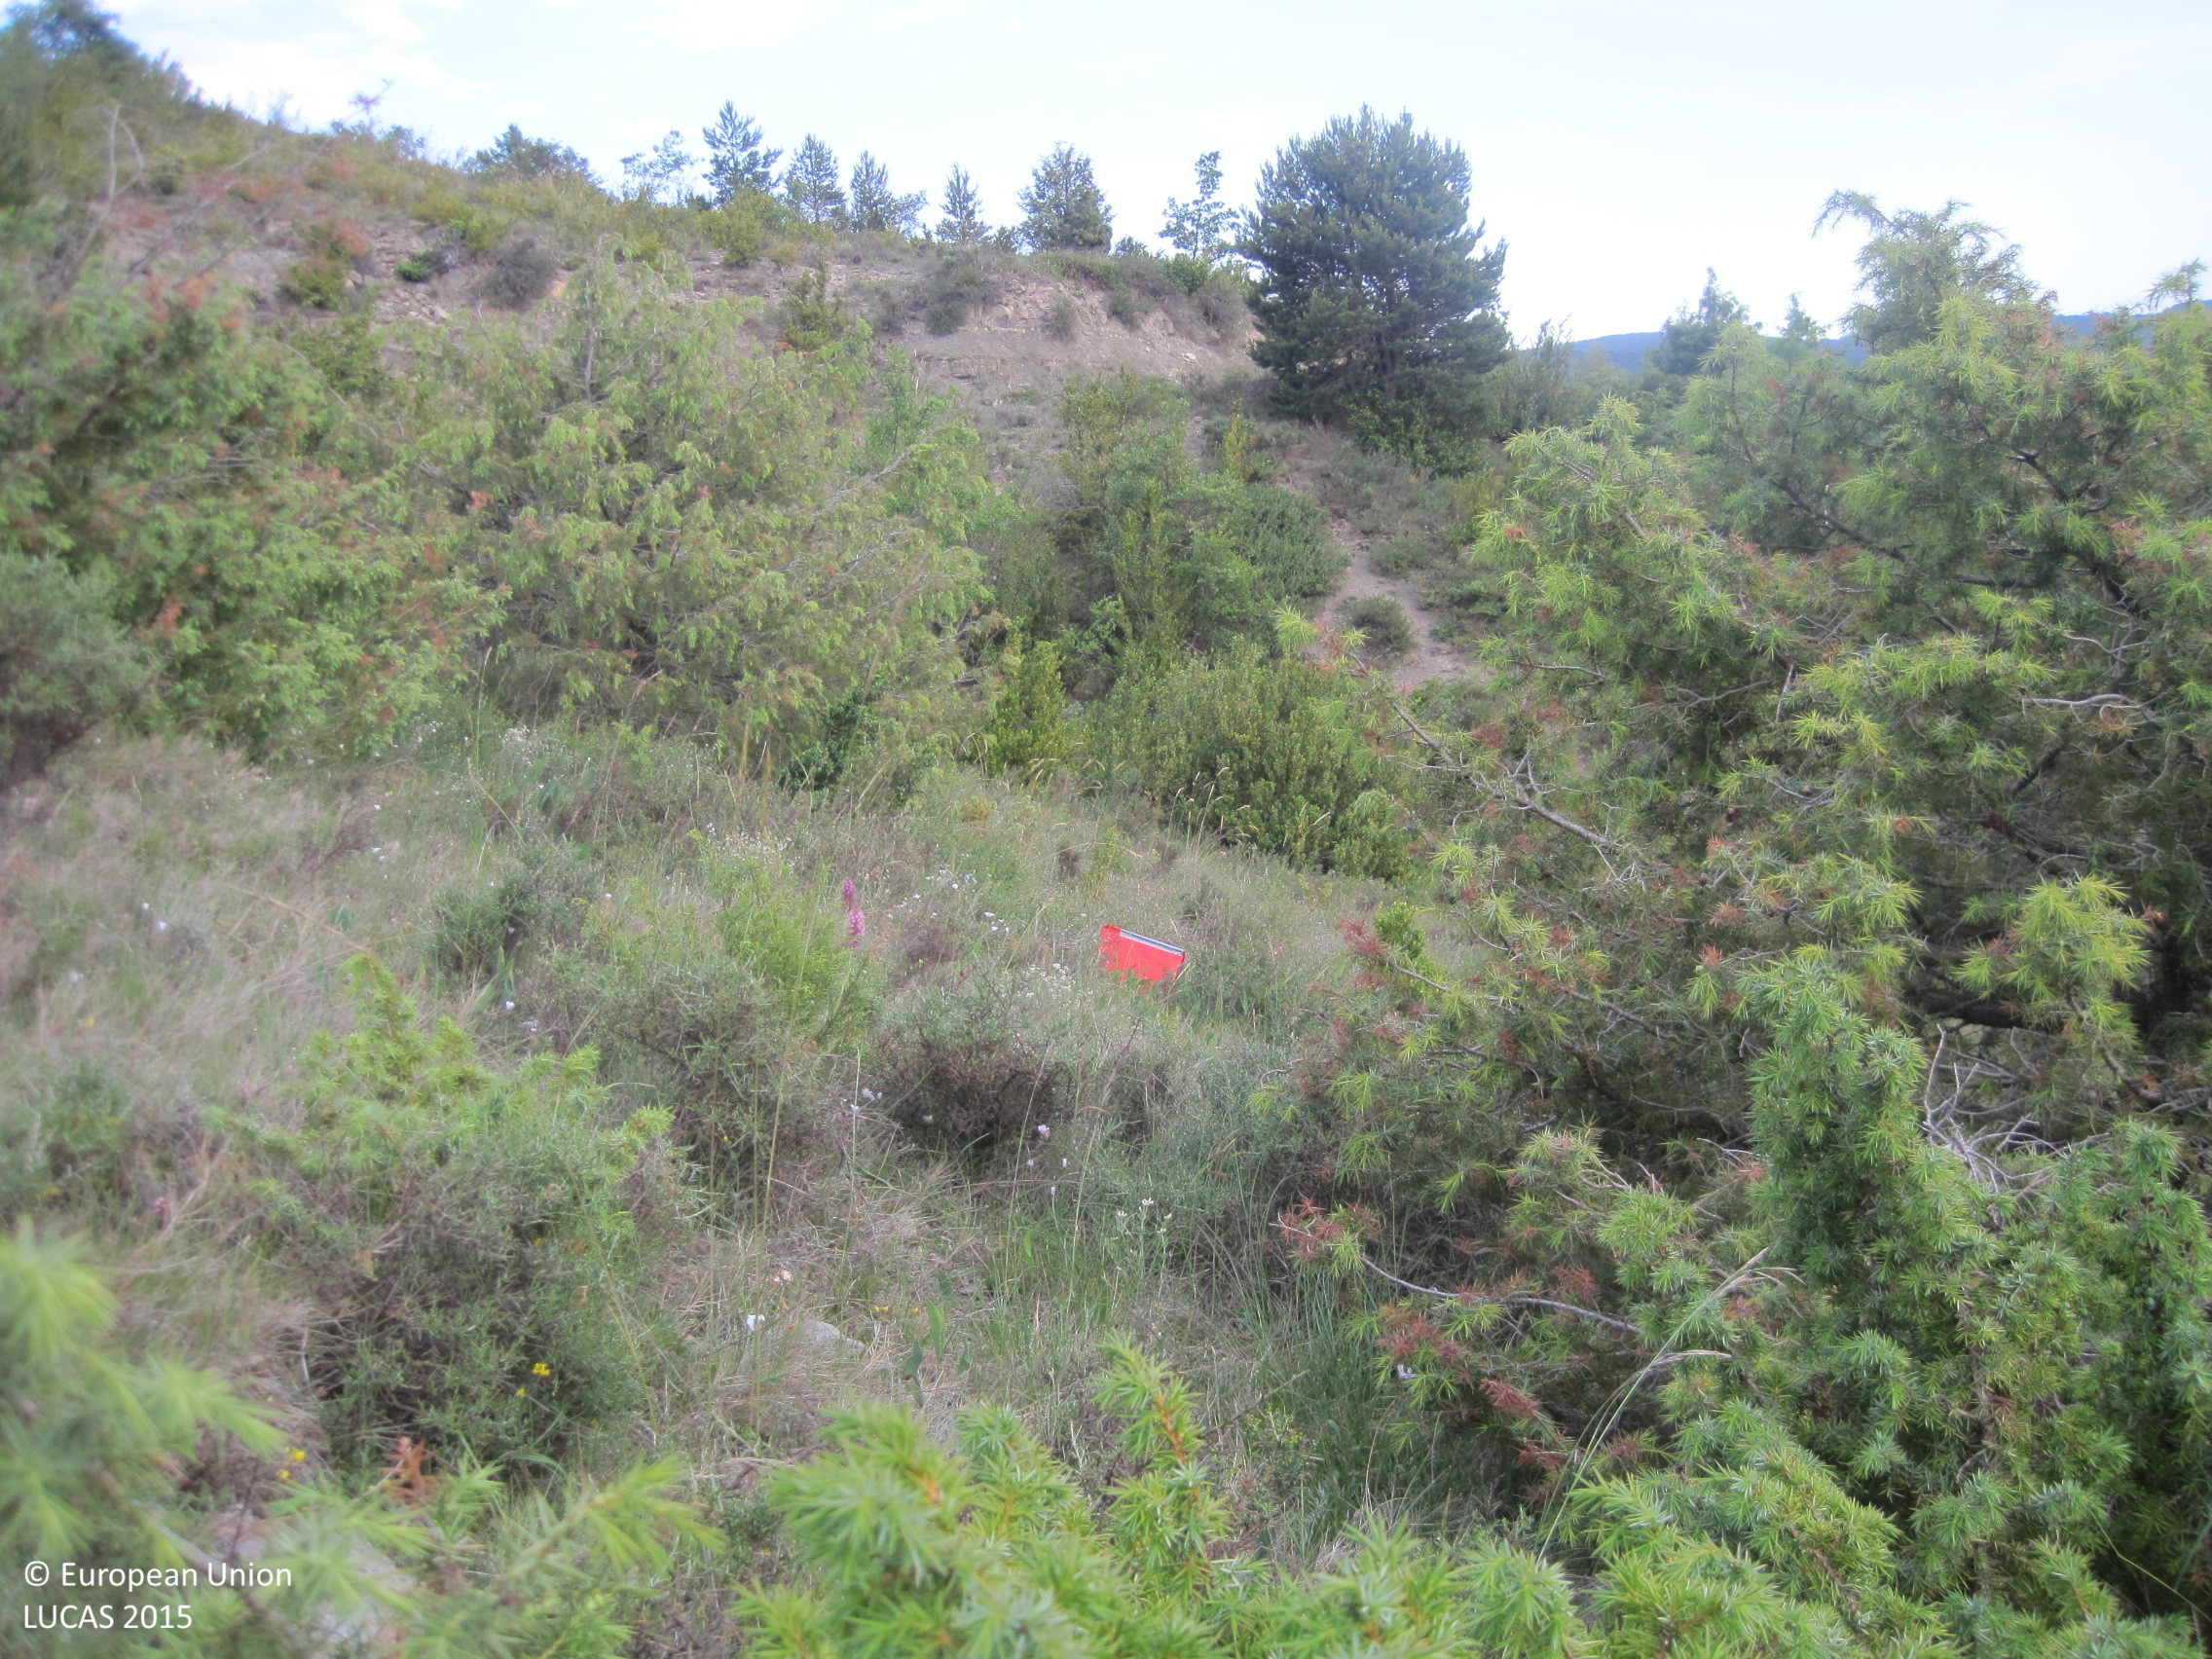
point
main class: Shrubland
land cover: Shrubland without tree cover
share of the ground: > 75 %
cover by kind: herbaceous plants 60 %, shrubs 40 %
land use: Semi-natural and natural areas not in use
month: June
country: ES
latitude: 42.6917
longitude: -1.1528
